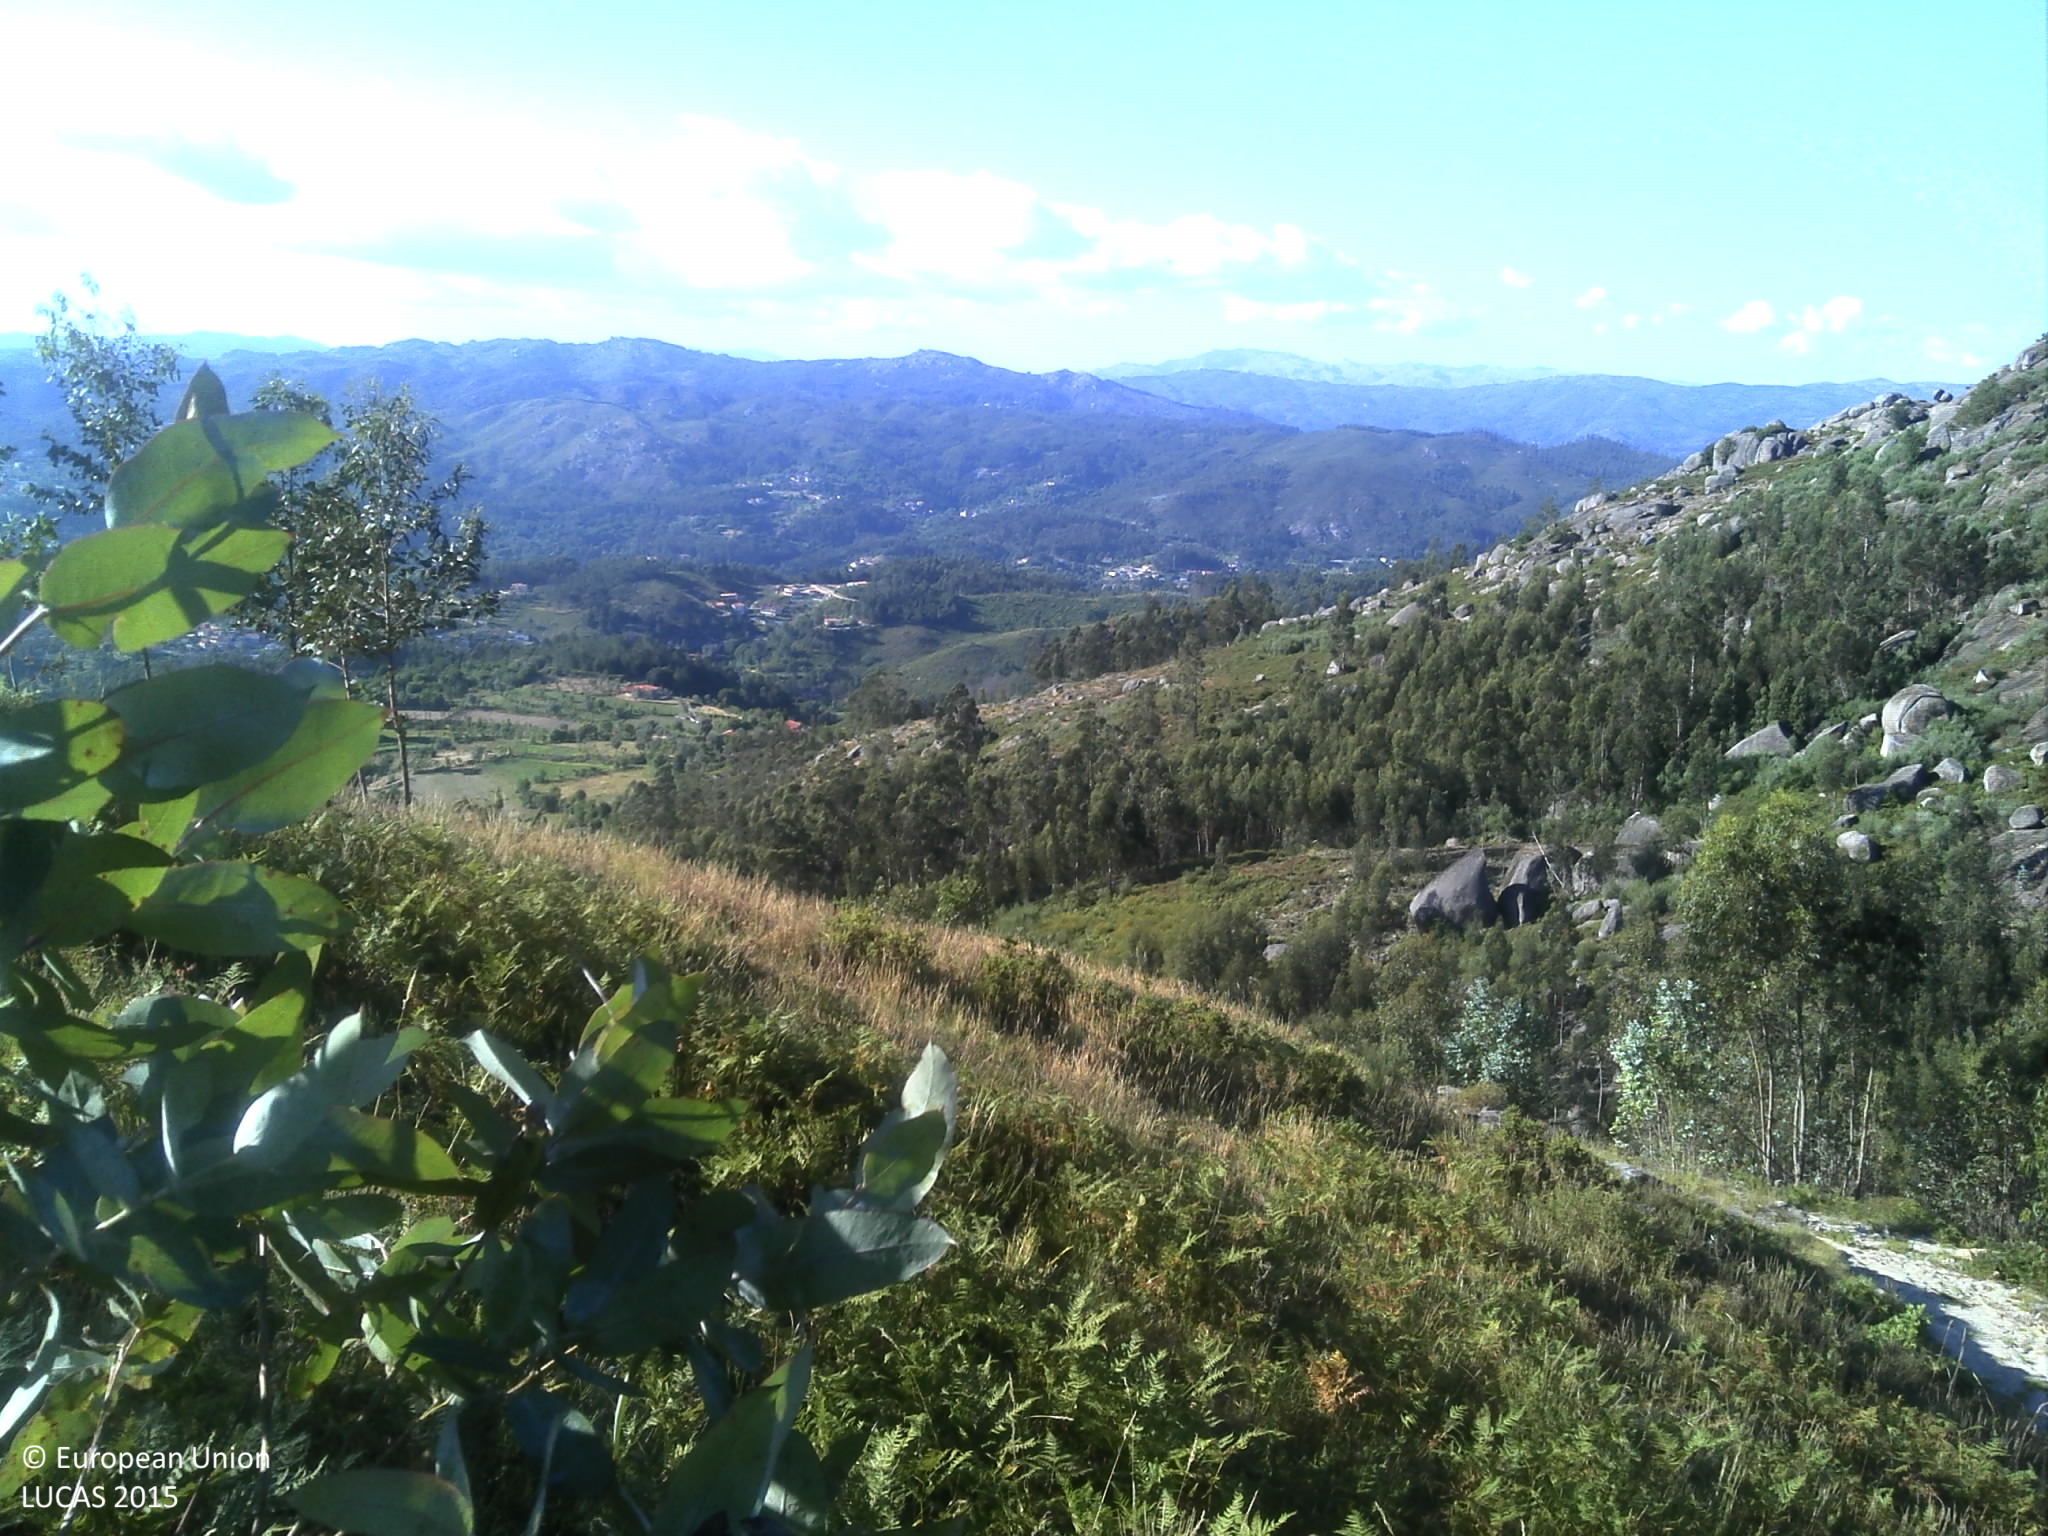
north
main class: Shrubland
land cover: Shrubland with sparse tree cover
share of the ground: > 75 %
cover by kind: shrubs 85 %, broadleaved forest trees 5 %, herbaceous plants 5 %, unconsolidated bare surface 5 %
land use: Agriculture (excluding fallow land and kitchen gardens)
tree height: < 5 m
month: June
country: PT
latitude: 41.5491
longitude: -8.1650
